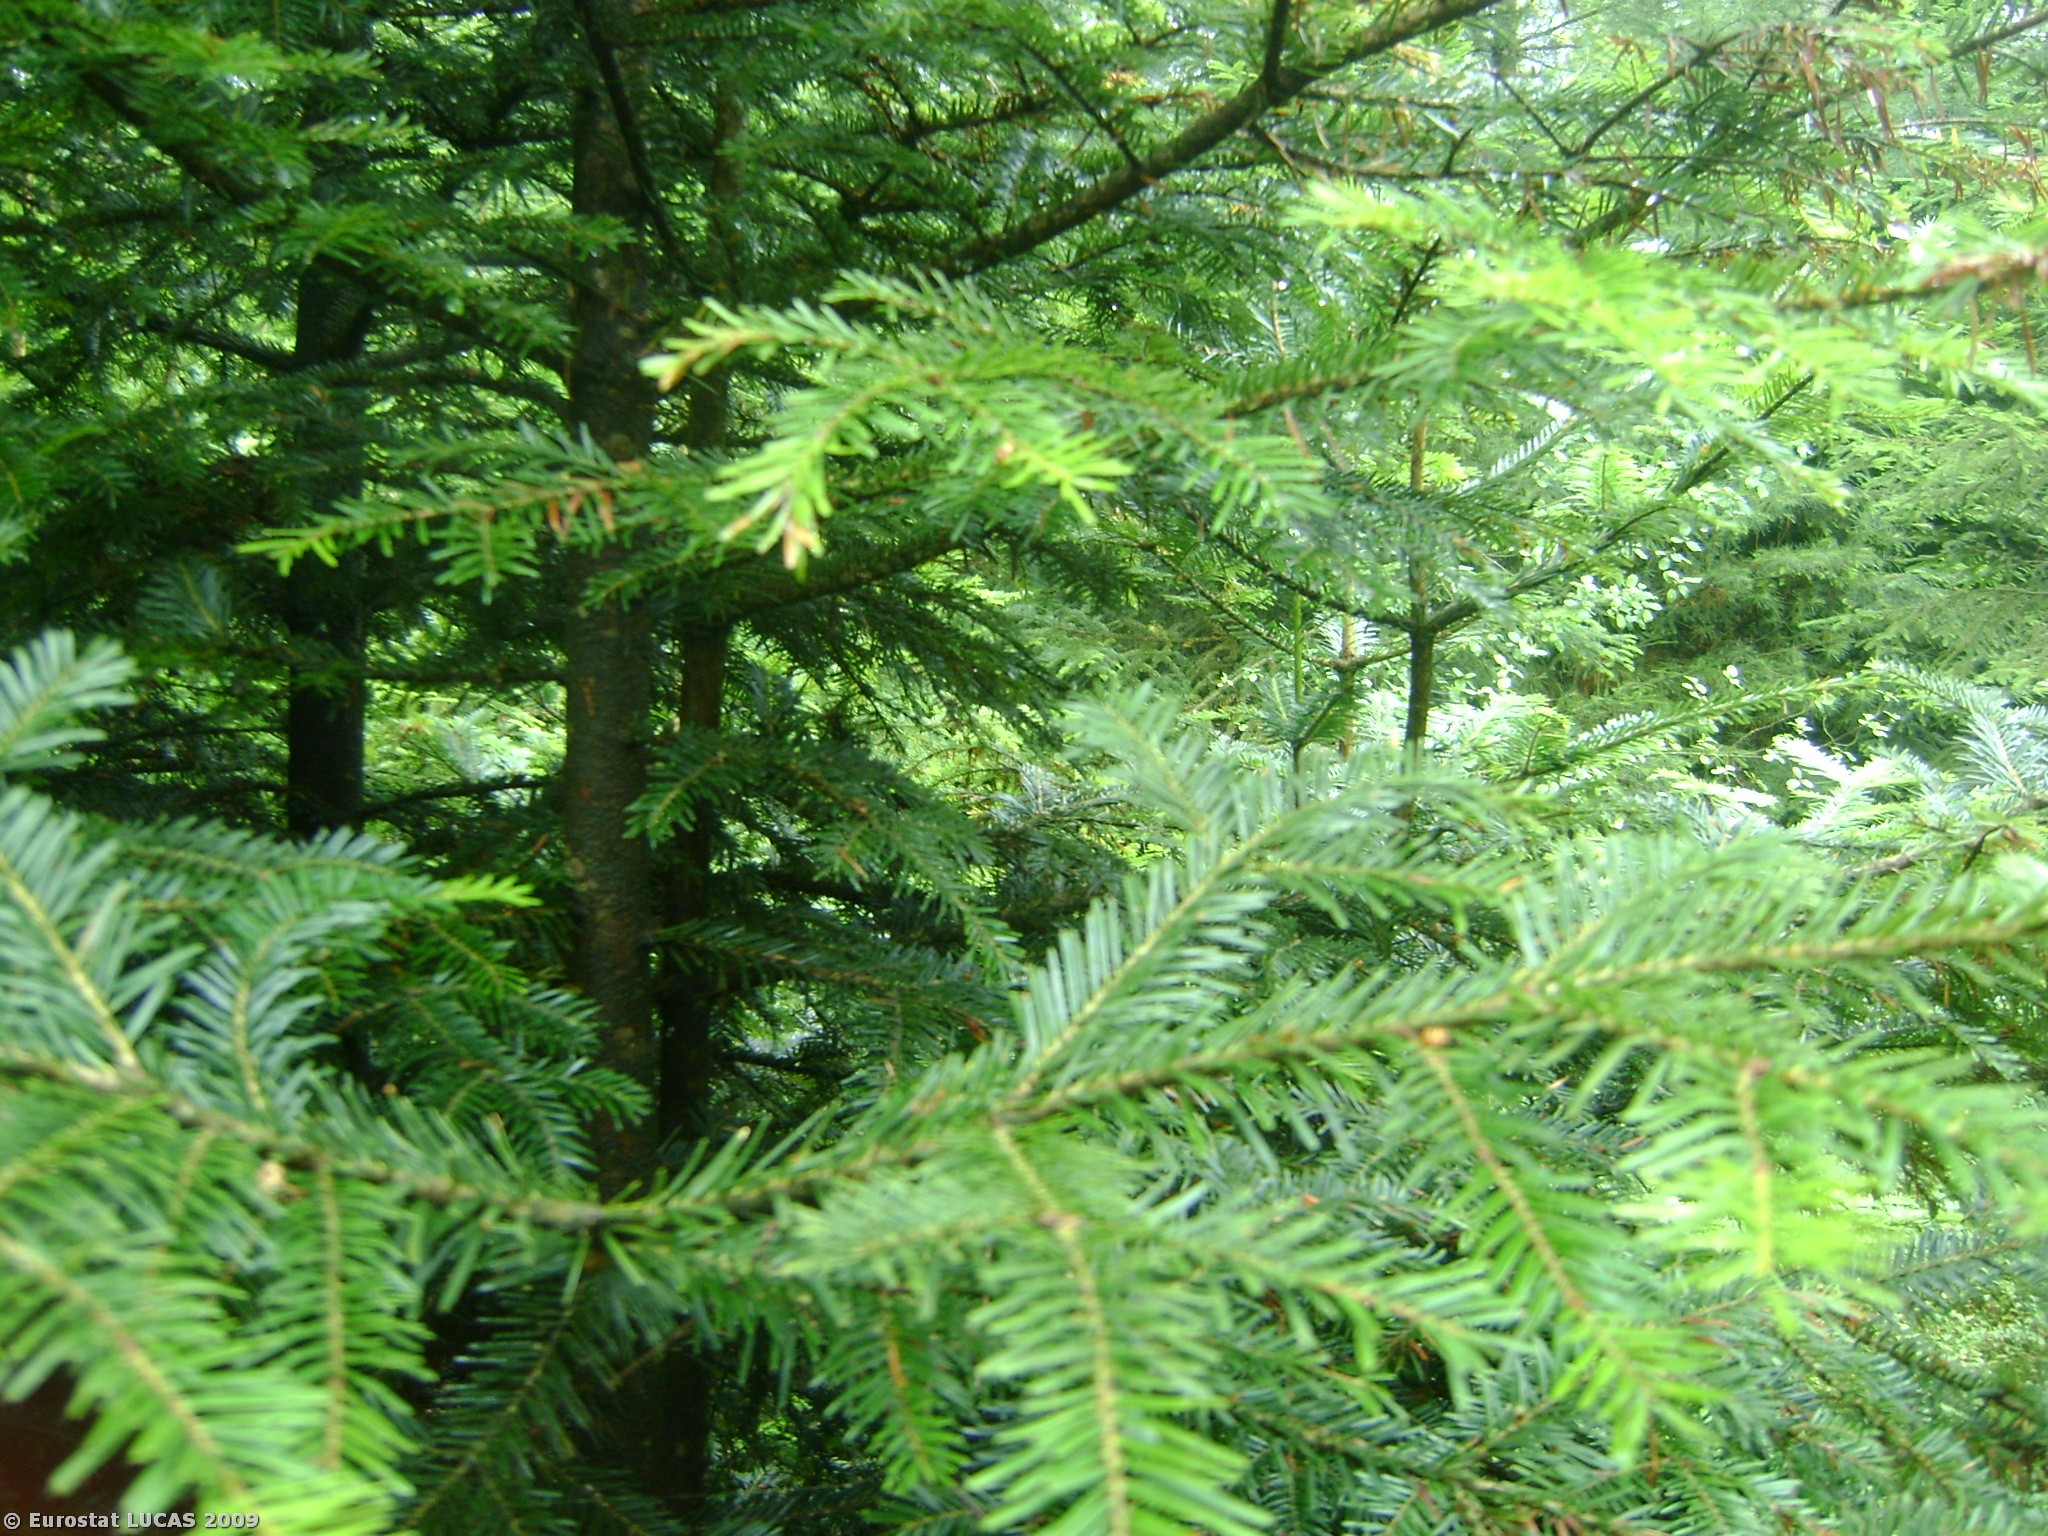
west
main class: Woodland
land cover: Coniferous woodland
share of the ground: > 75 %
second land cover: Shrubland with sparse tree cover
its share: 10 - 25 %
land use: Forestry
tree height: < 5 m
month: June
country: AT
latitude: 48.1041
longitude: 13.2355
